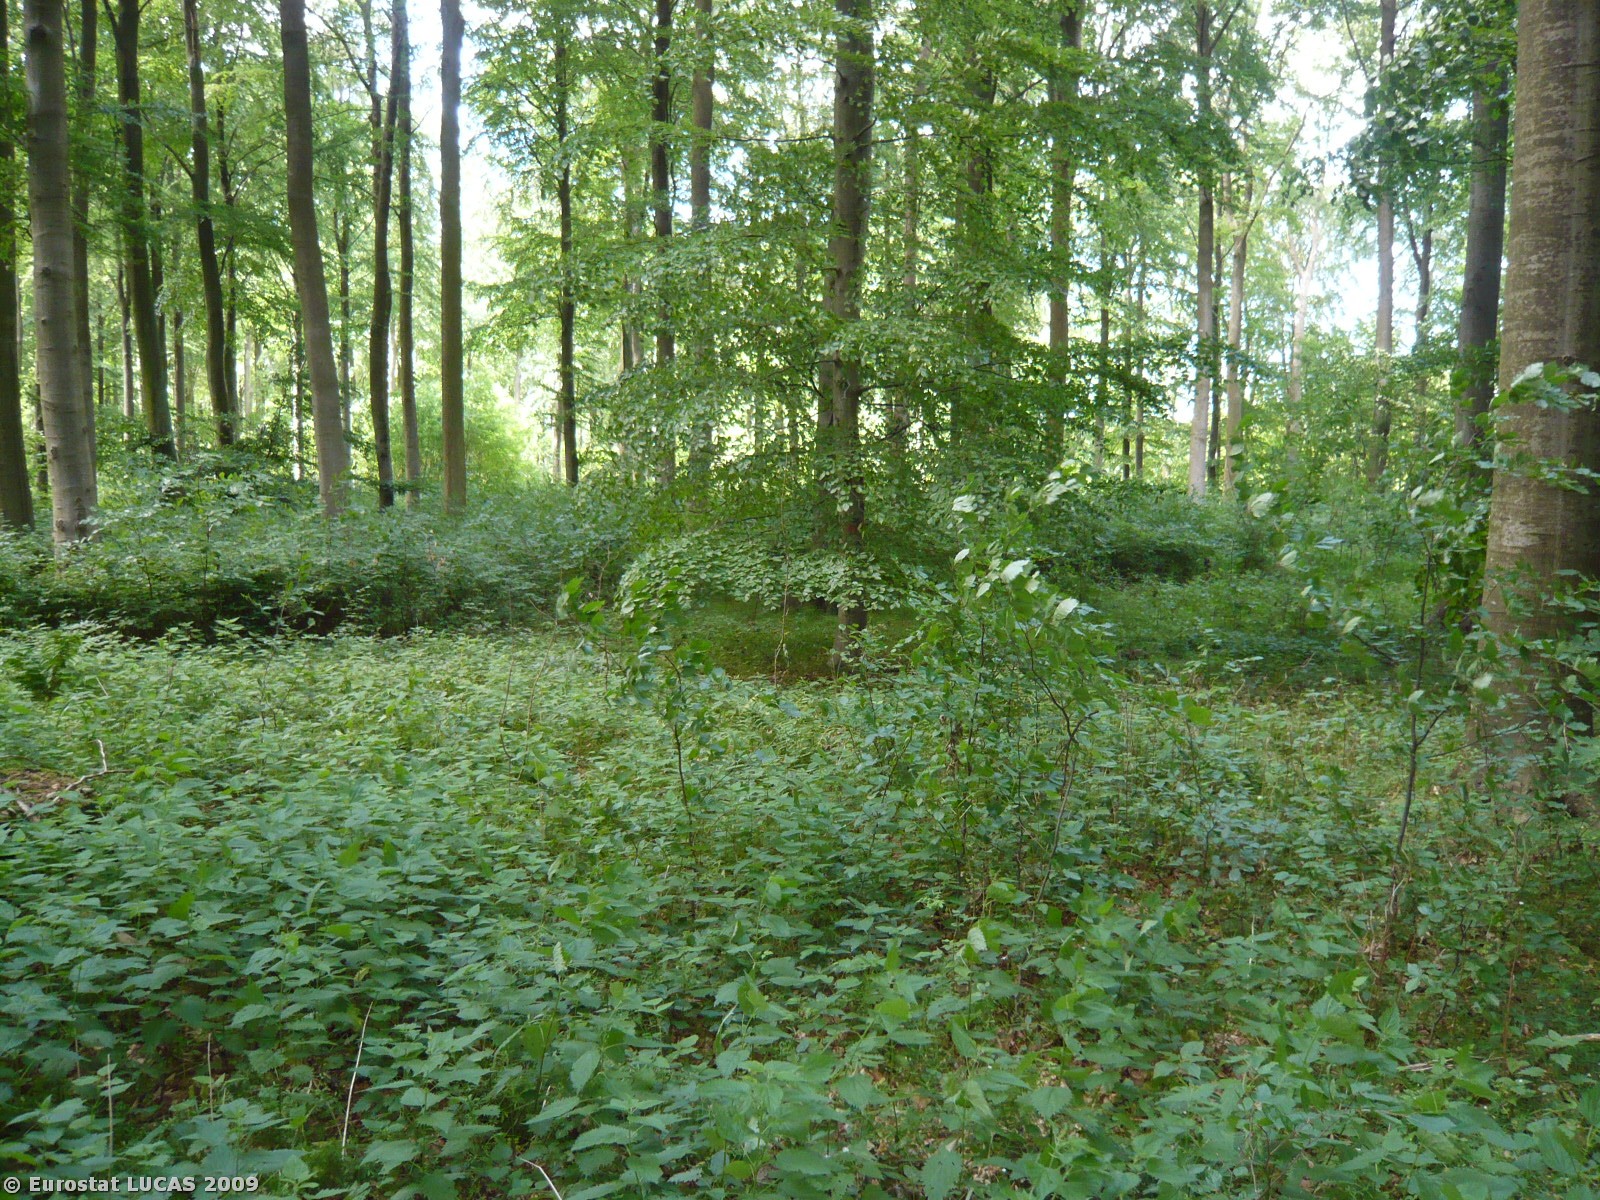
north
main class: Woodland
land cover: Broadleaved woodland
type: mesophytic deciduous forest
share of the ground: > 75 %
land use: Forestry
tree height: > 5 m
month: June
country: DK
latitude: 54.8686
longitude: 11.3235
